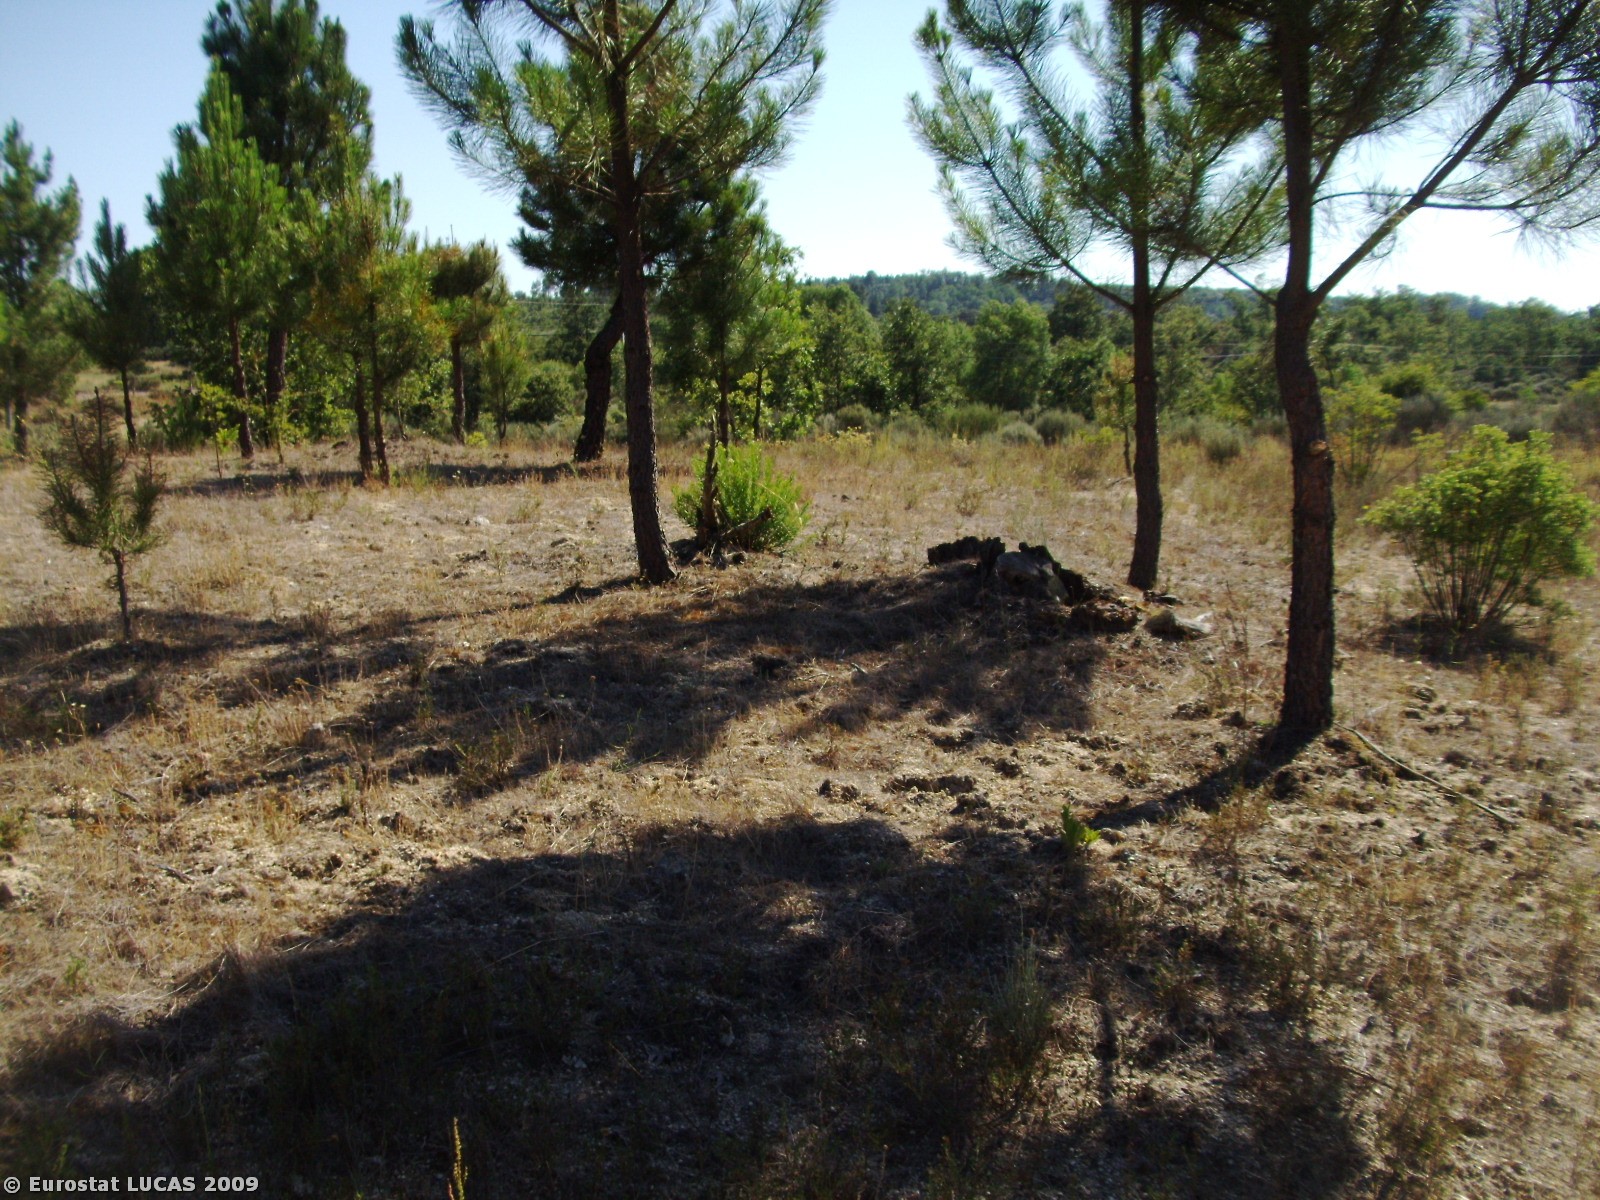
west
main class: Woodland
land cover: Mixed woodland
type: coniferous forest of the mediterranean region
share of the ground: 50 - 75 %
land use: Forestry
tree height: > 5 m
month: July
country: PT
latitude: 40.5164
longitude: -7.0368
